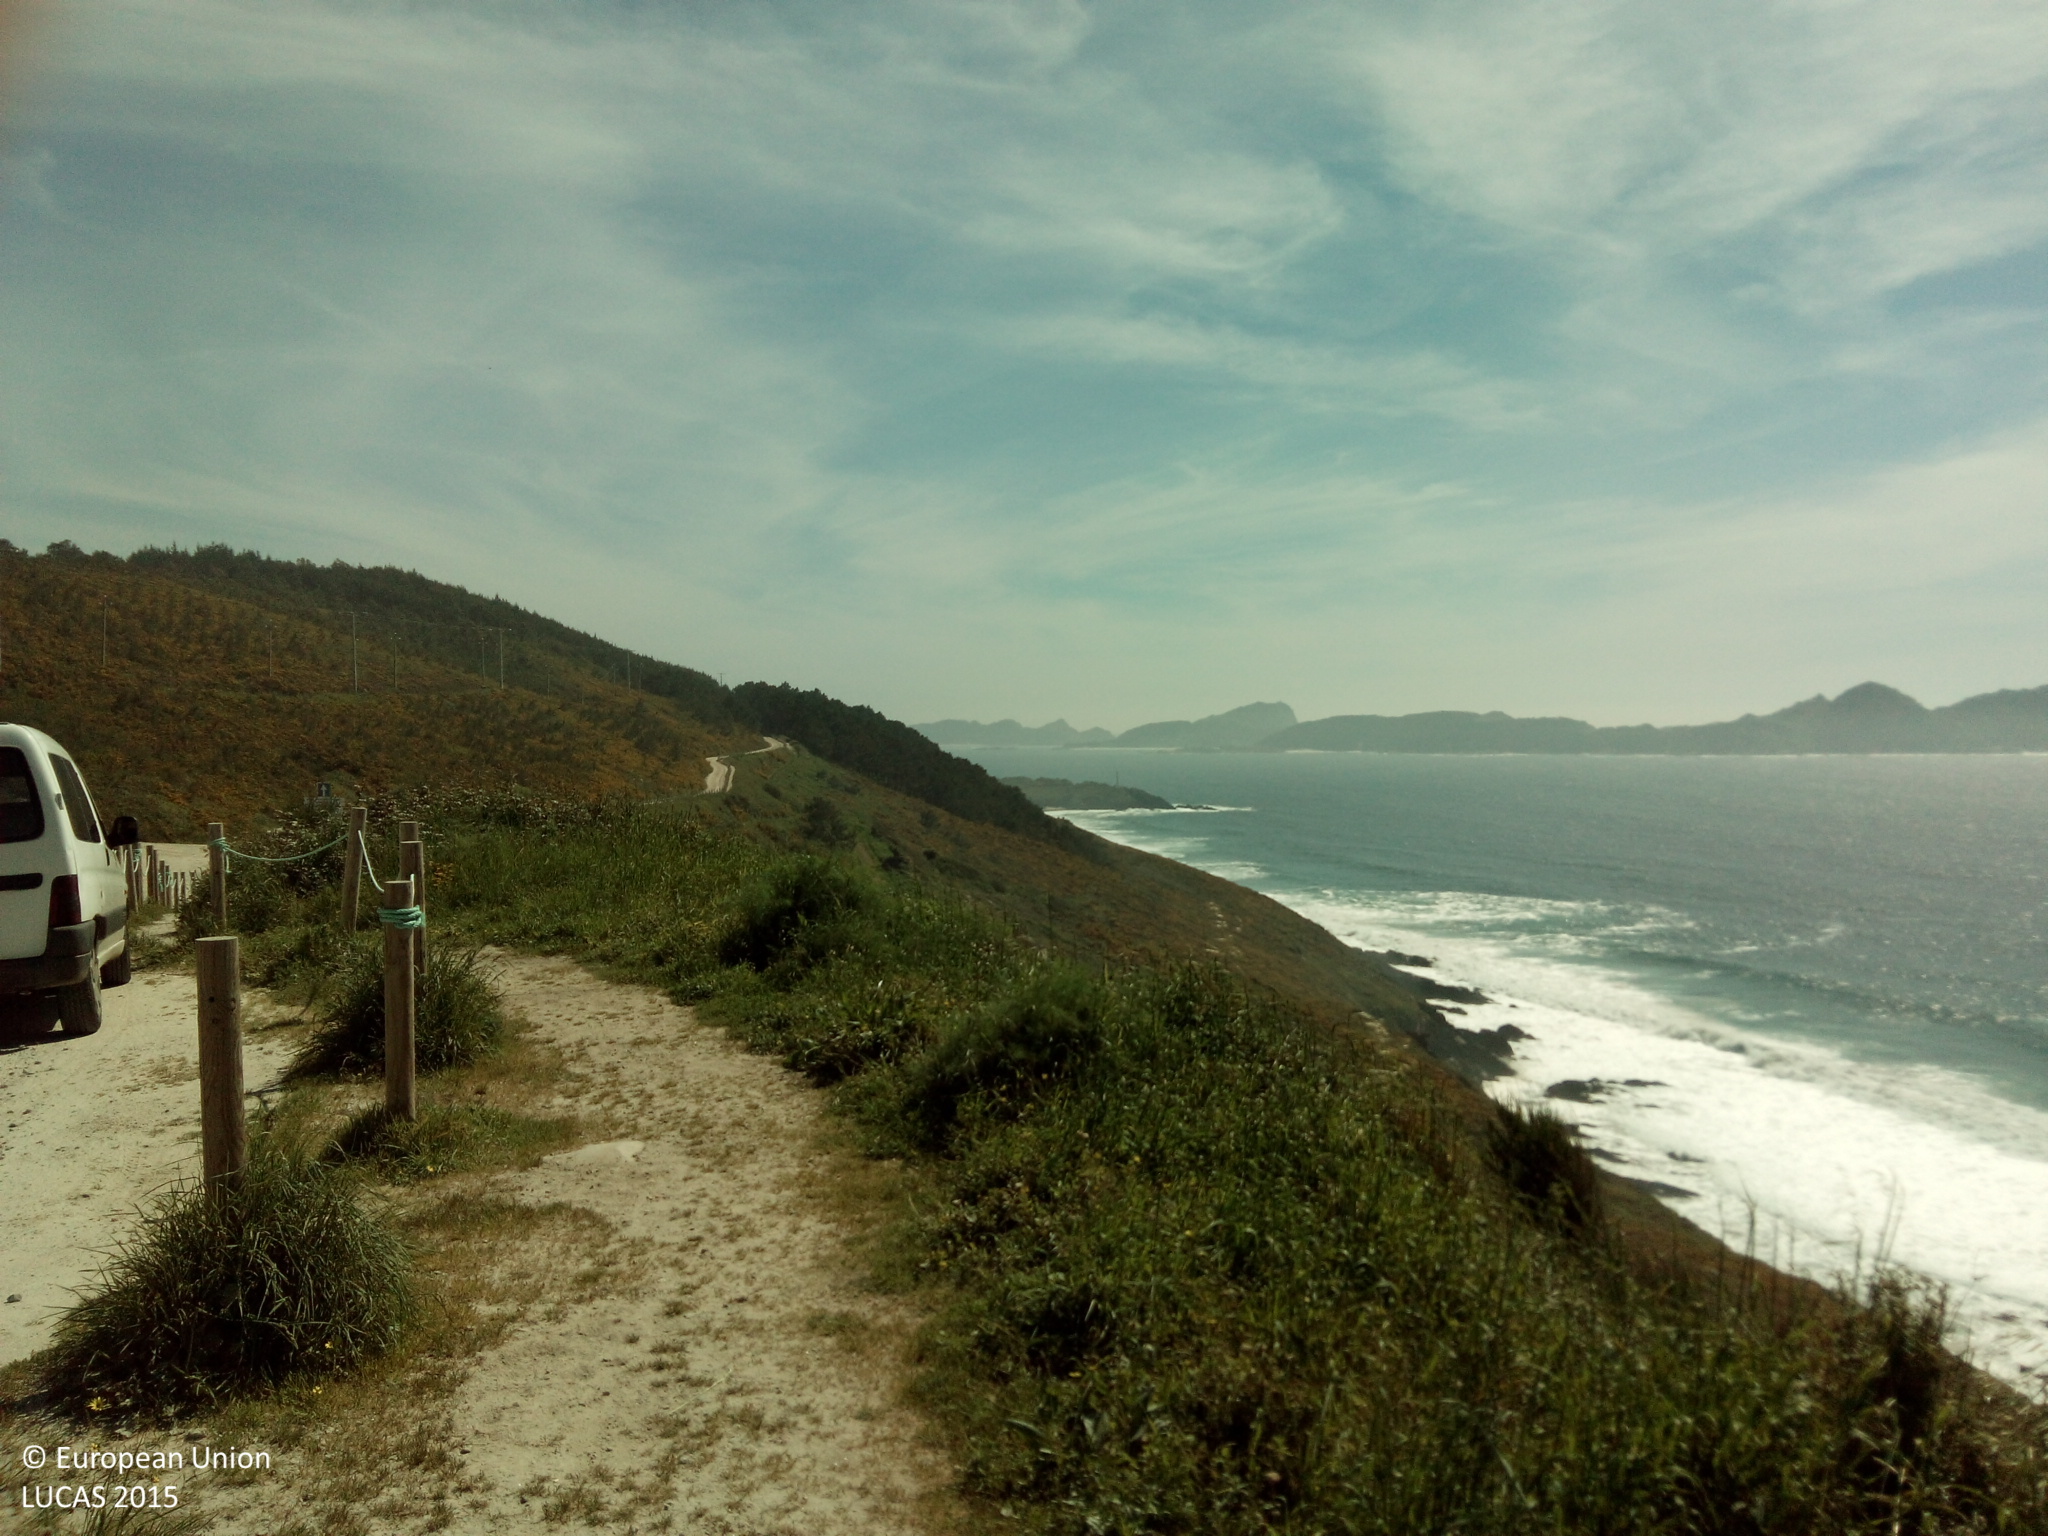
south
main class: Shrubland
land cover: Shrubland without tree cover
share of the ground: > 75 %
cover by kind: shrubs 75 %
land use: Semi-natural and natural areas not in use
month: May
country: ES
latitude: 42.2684
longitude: -8.8618
